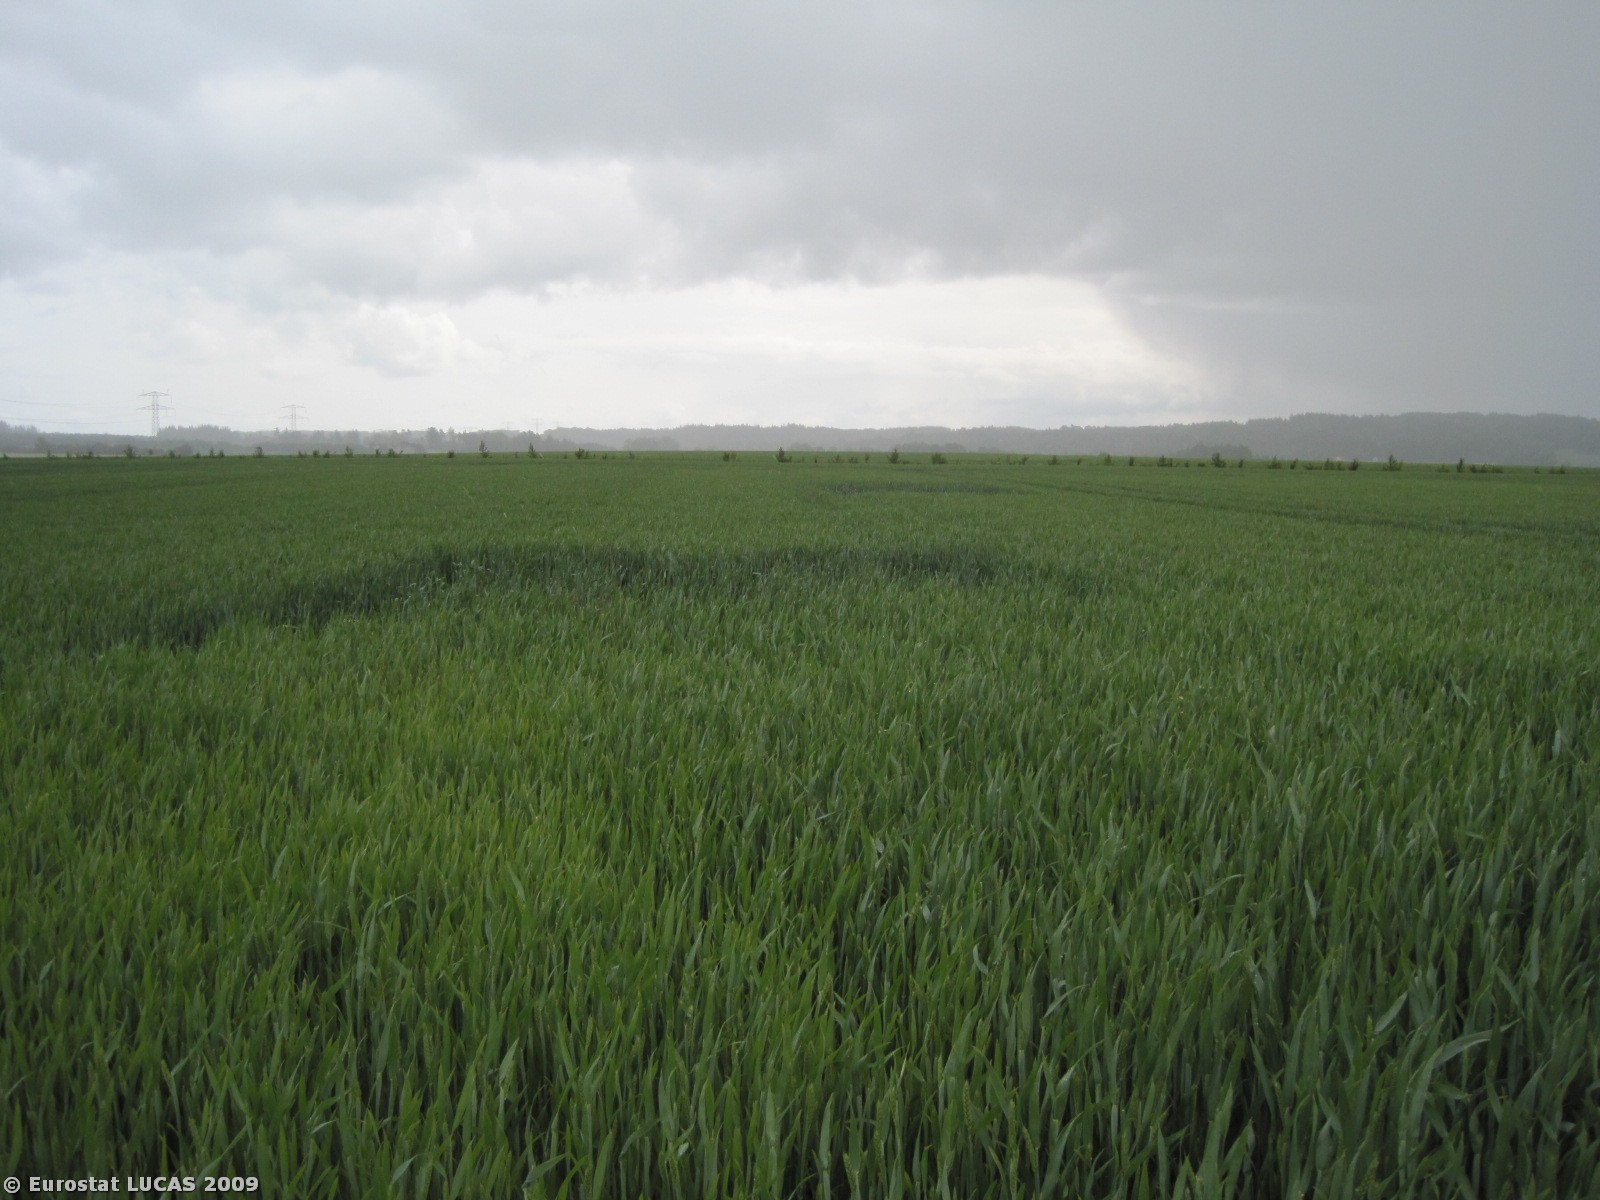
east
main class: Cropland
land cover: Common wheat
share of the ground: > 75 %
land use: Agriculture (excluding fallow land and kitchen gardens)
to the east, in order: Common wheat; Electric lines; Common wheat; Grass margins; Broadleaved woodland; Grass margins; Common wheat
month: June
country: DK
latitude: 56.9426
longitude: 9.7866
